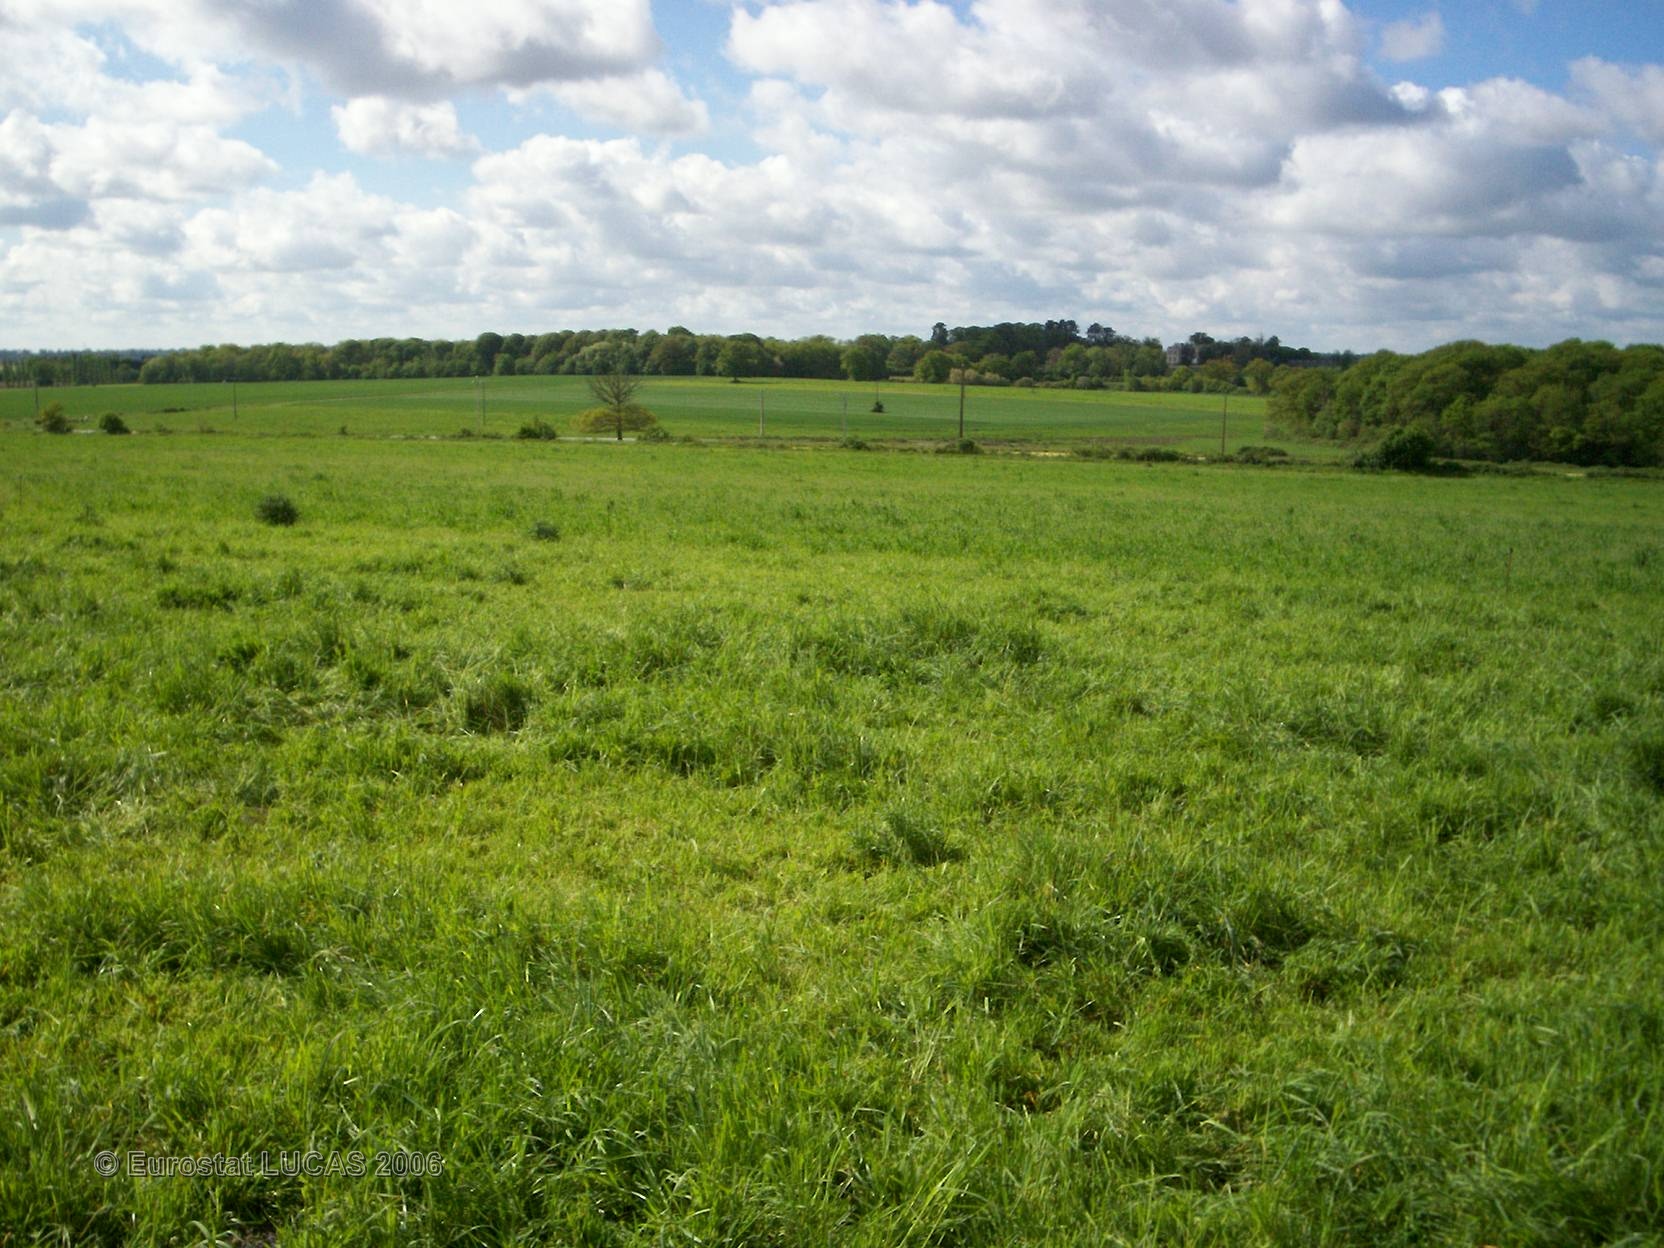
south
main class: Grassland
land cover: Grassland without tree/shrub cover
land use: Agriculture (excluding fallow land and kitchen gardens)
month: May
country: FR
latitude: 47.8260
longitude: -1.0861
